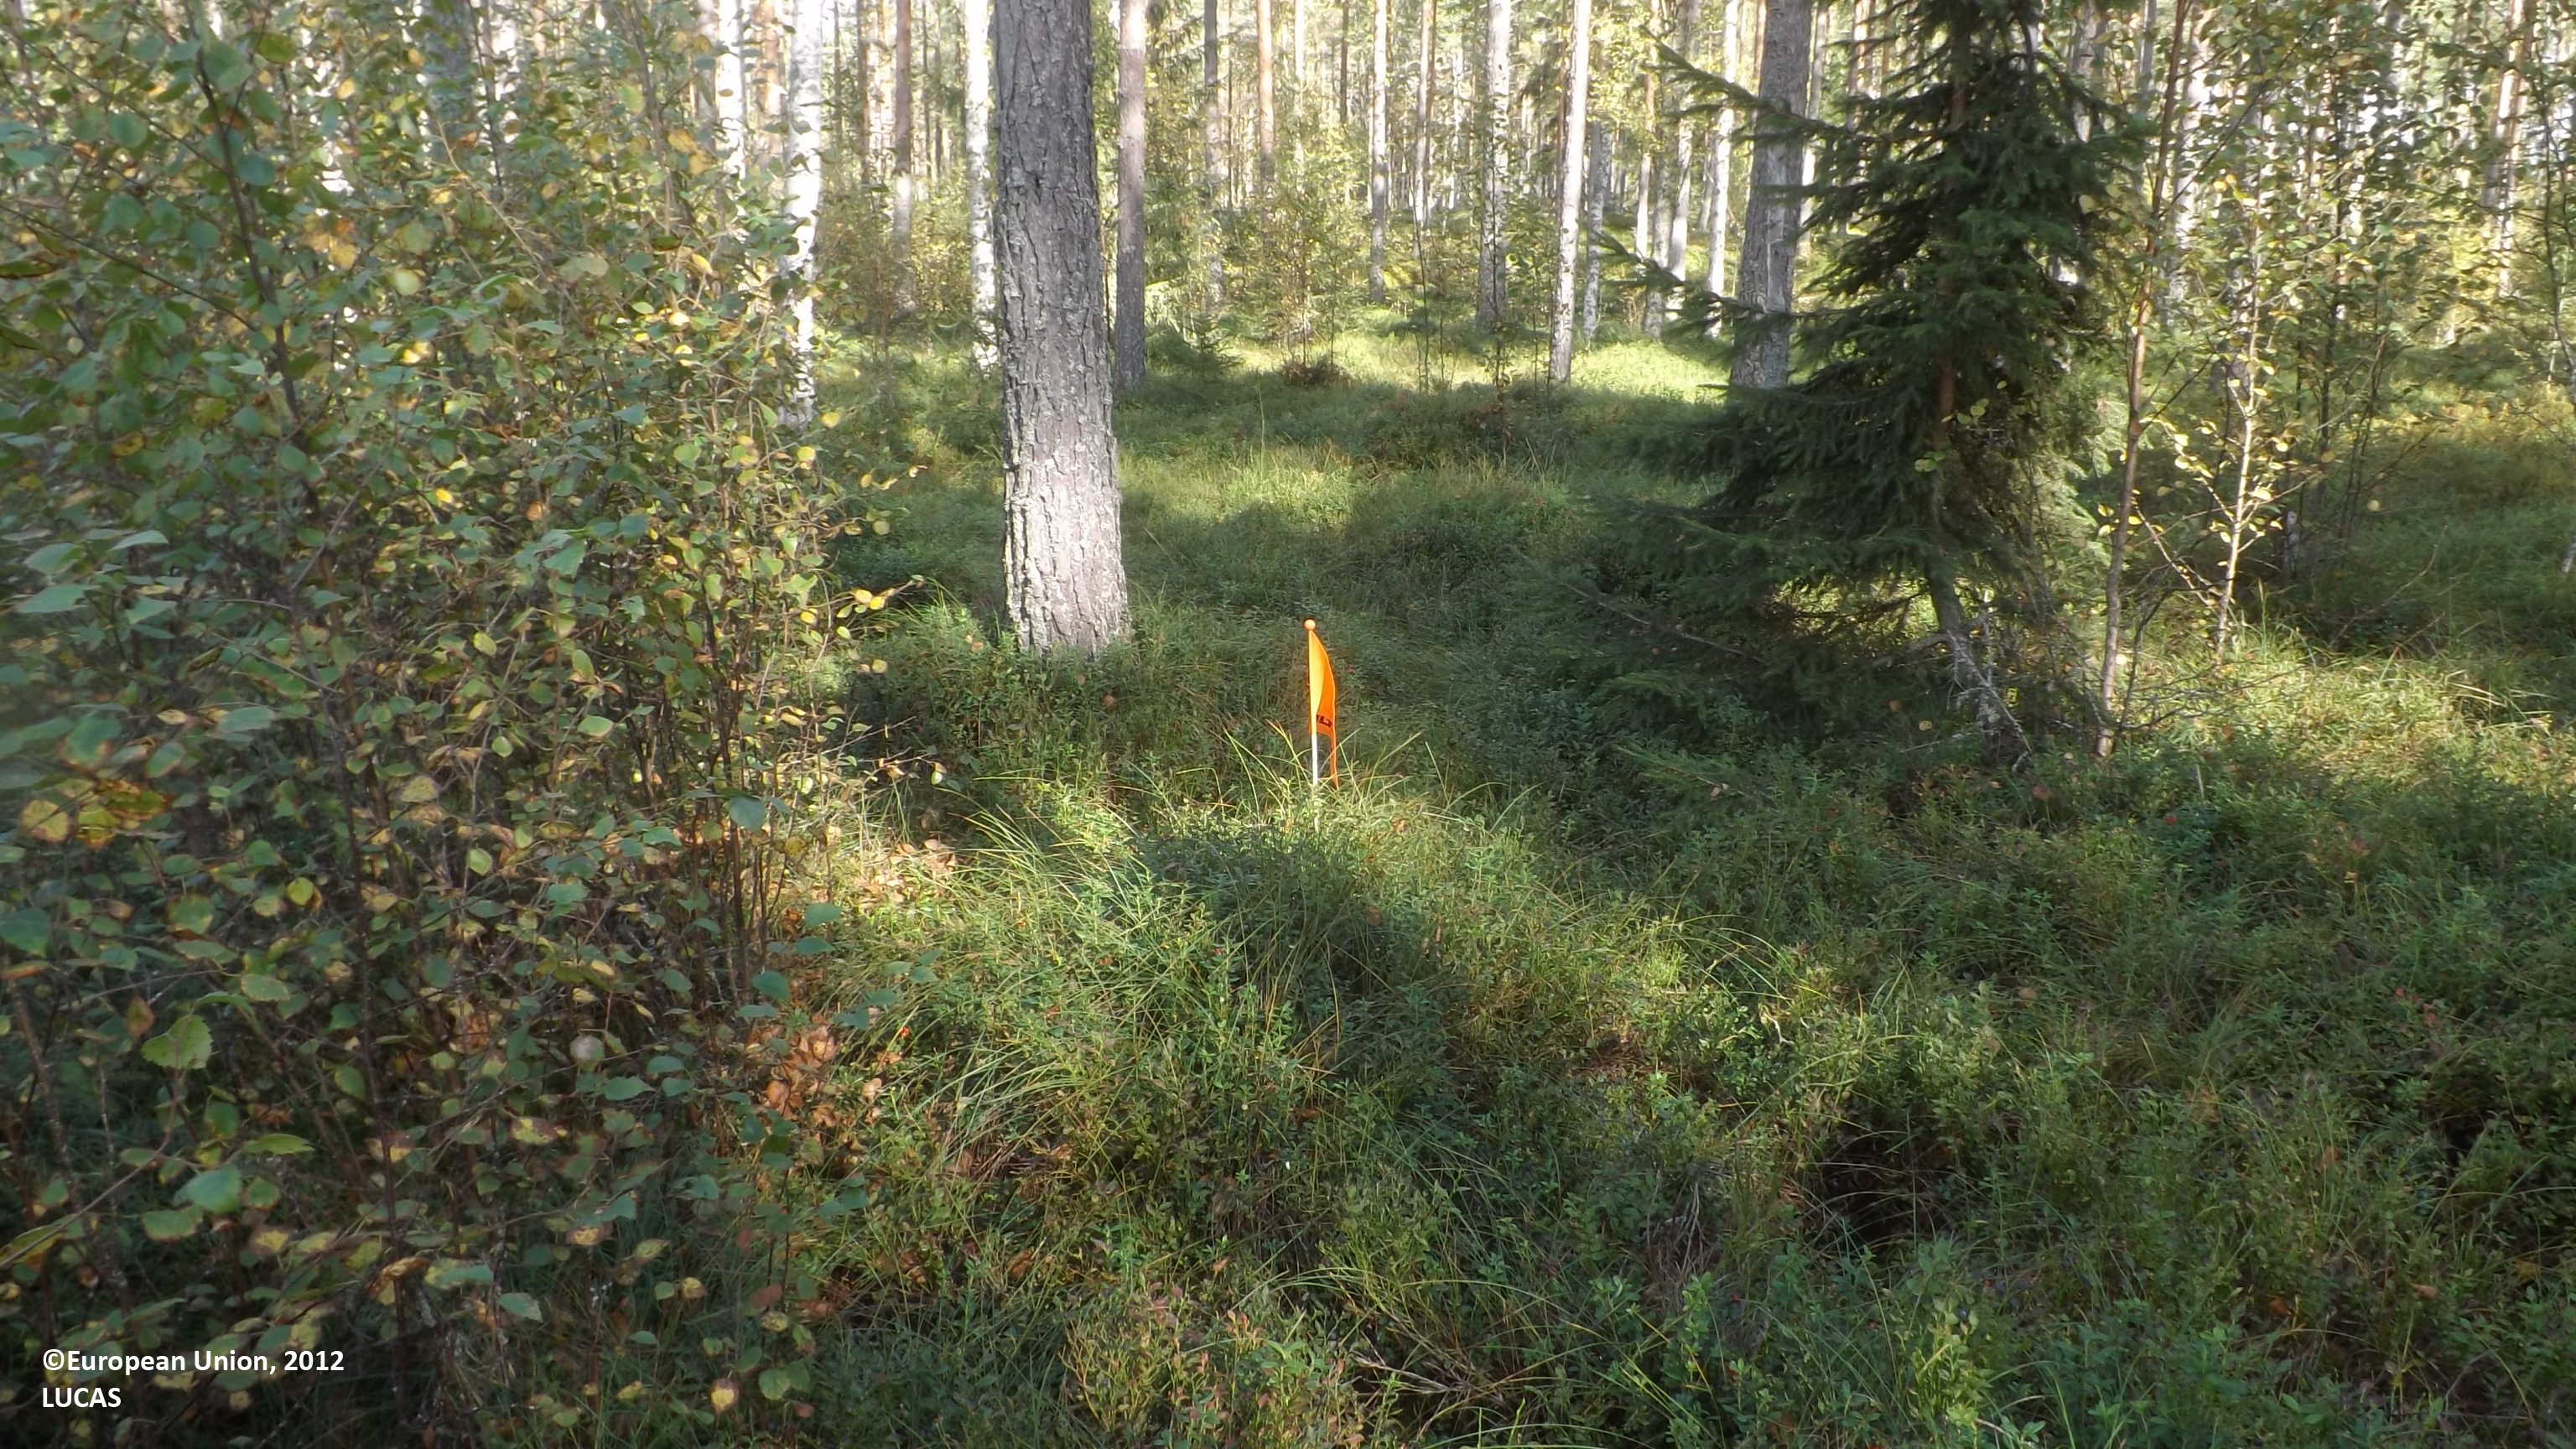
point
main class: Woodland
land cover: Pine dominated mixed woodland
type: boreal forest
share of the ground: 50 - 75 %
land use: Forestry
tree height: > 5 m
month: August
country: FI
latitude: 63.9076
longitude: 23.7358
